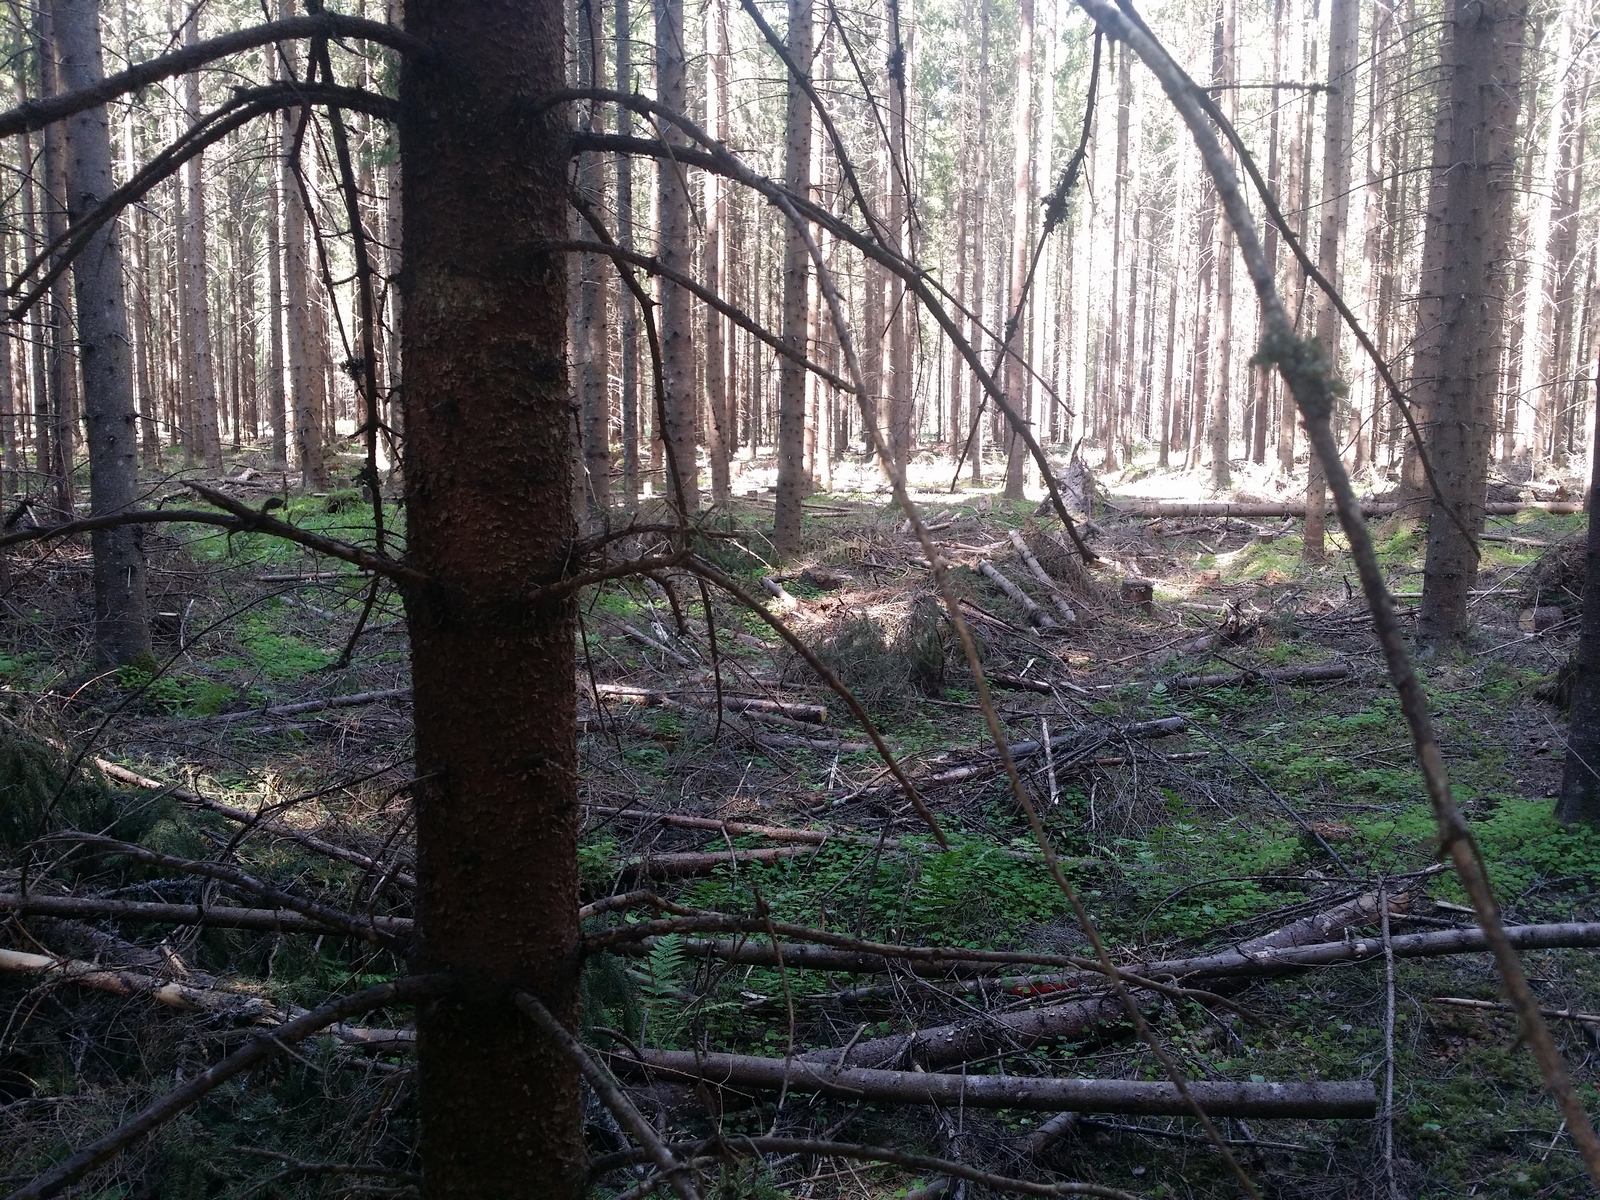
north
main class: Woodland
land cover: Spruce dominated coniferous woodland
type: hemiboreal forest and nemoral coniferous forest and mixed broadleaved-coniferous forest
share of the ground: > 75 %
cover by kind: coniferous forest trees 75 %, lichens and mosses 15 %, herbaceous plants 10 %
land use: Forestry
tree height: > 5 m
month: June
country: LV
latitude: 57.3258
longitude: 26.4343
